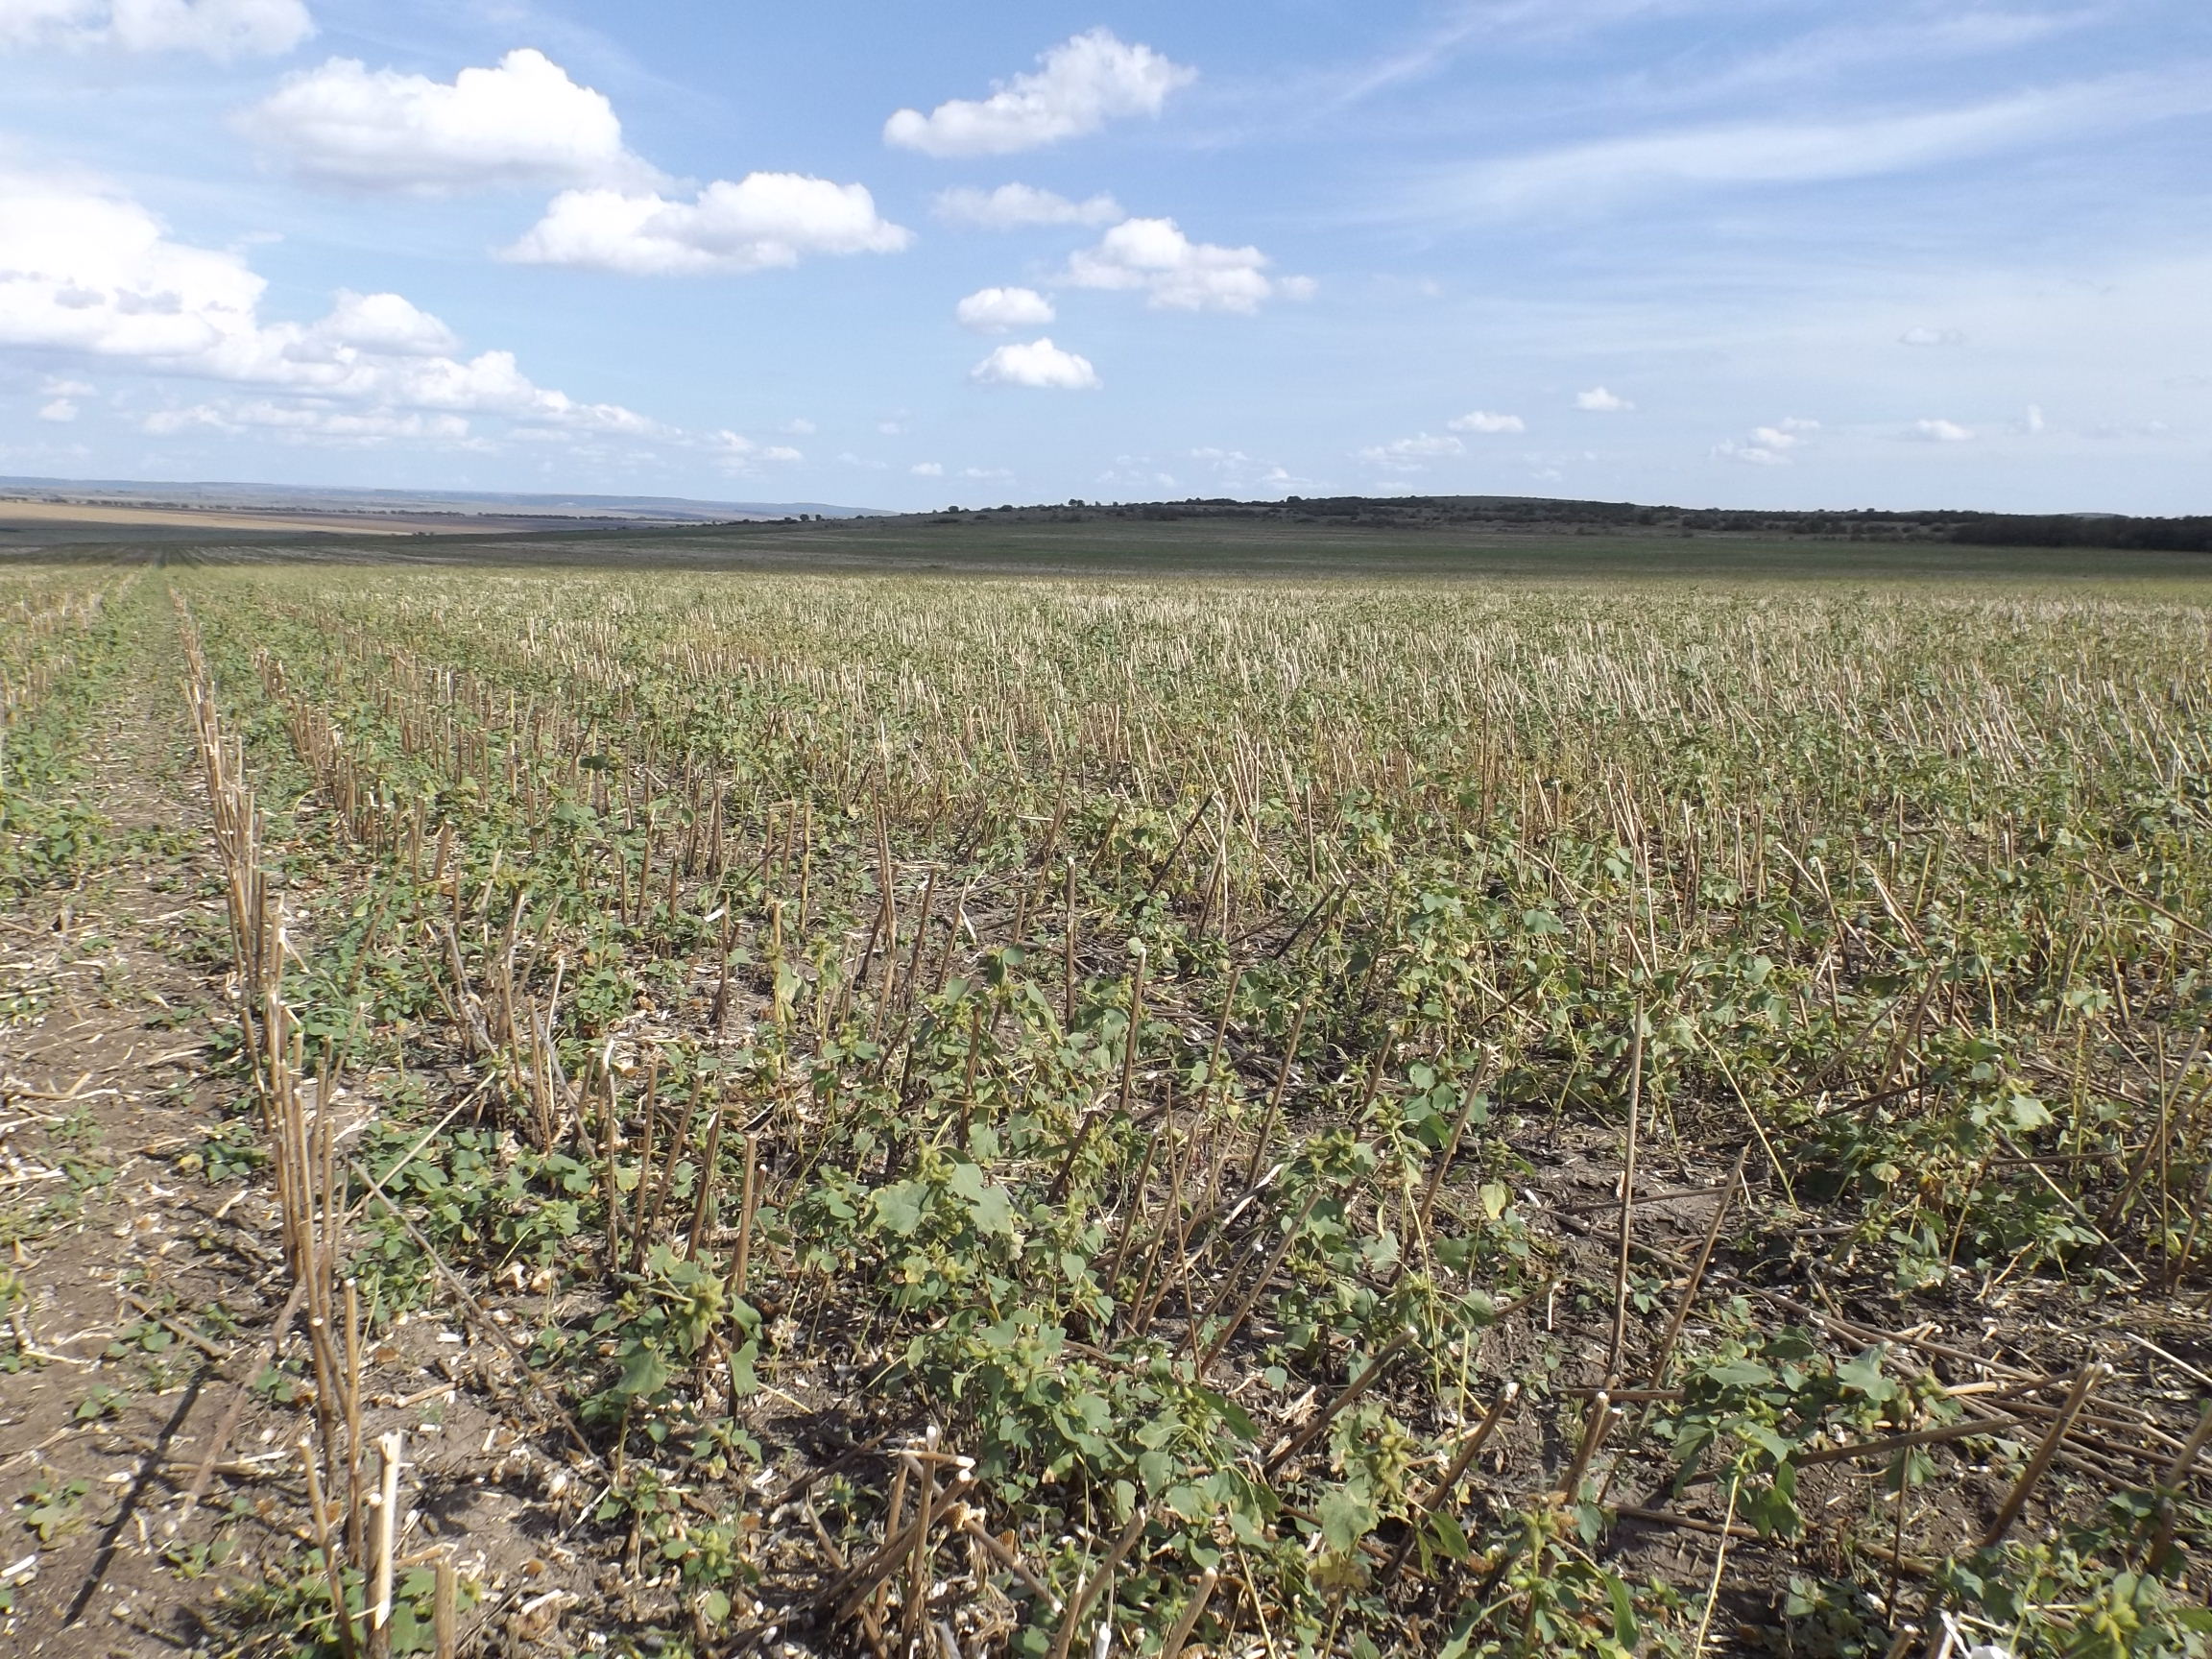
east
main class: Cropland
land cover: Sunflower
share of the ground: < 10 %
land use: Agriculture (excluding fallow land and kitchen gardens)
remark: Harvested field
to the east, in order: Sunflower
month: September
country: BG
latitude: 43.2832
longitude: 27.4411
